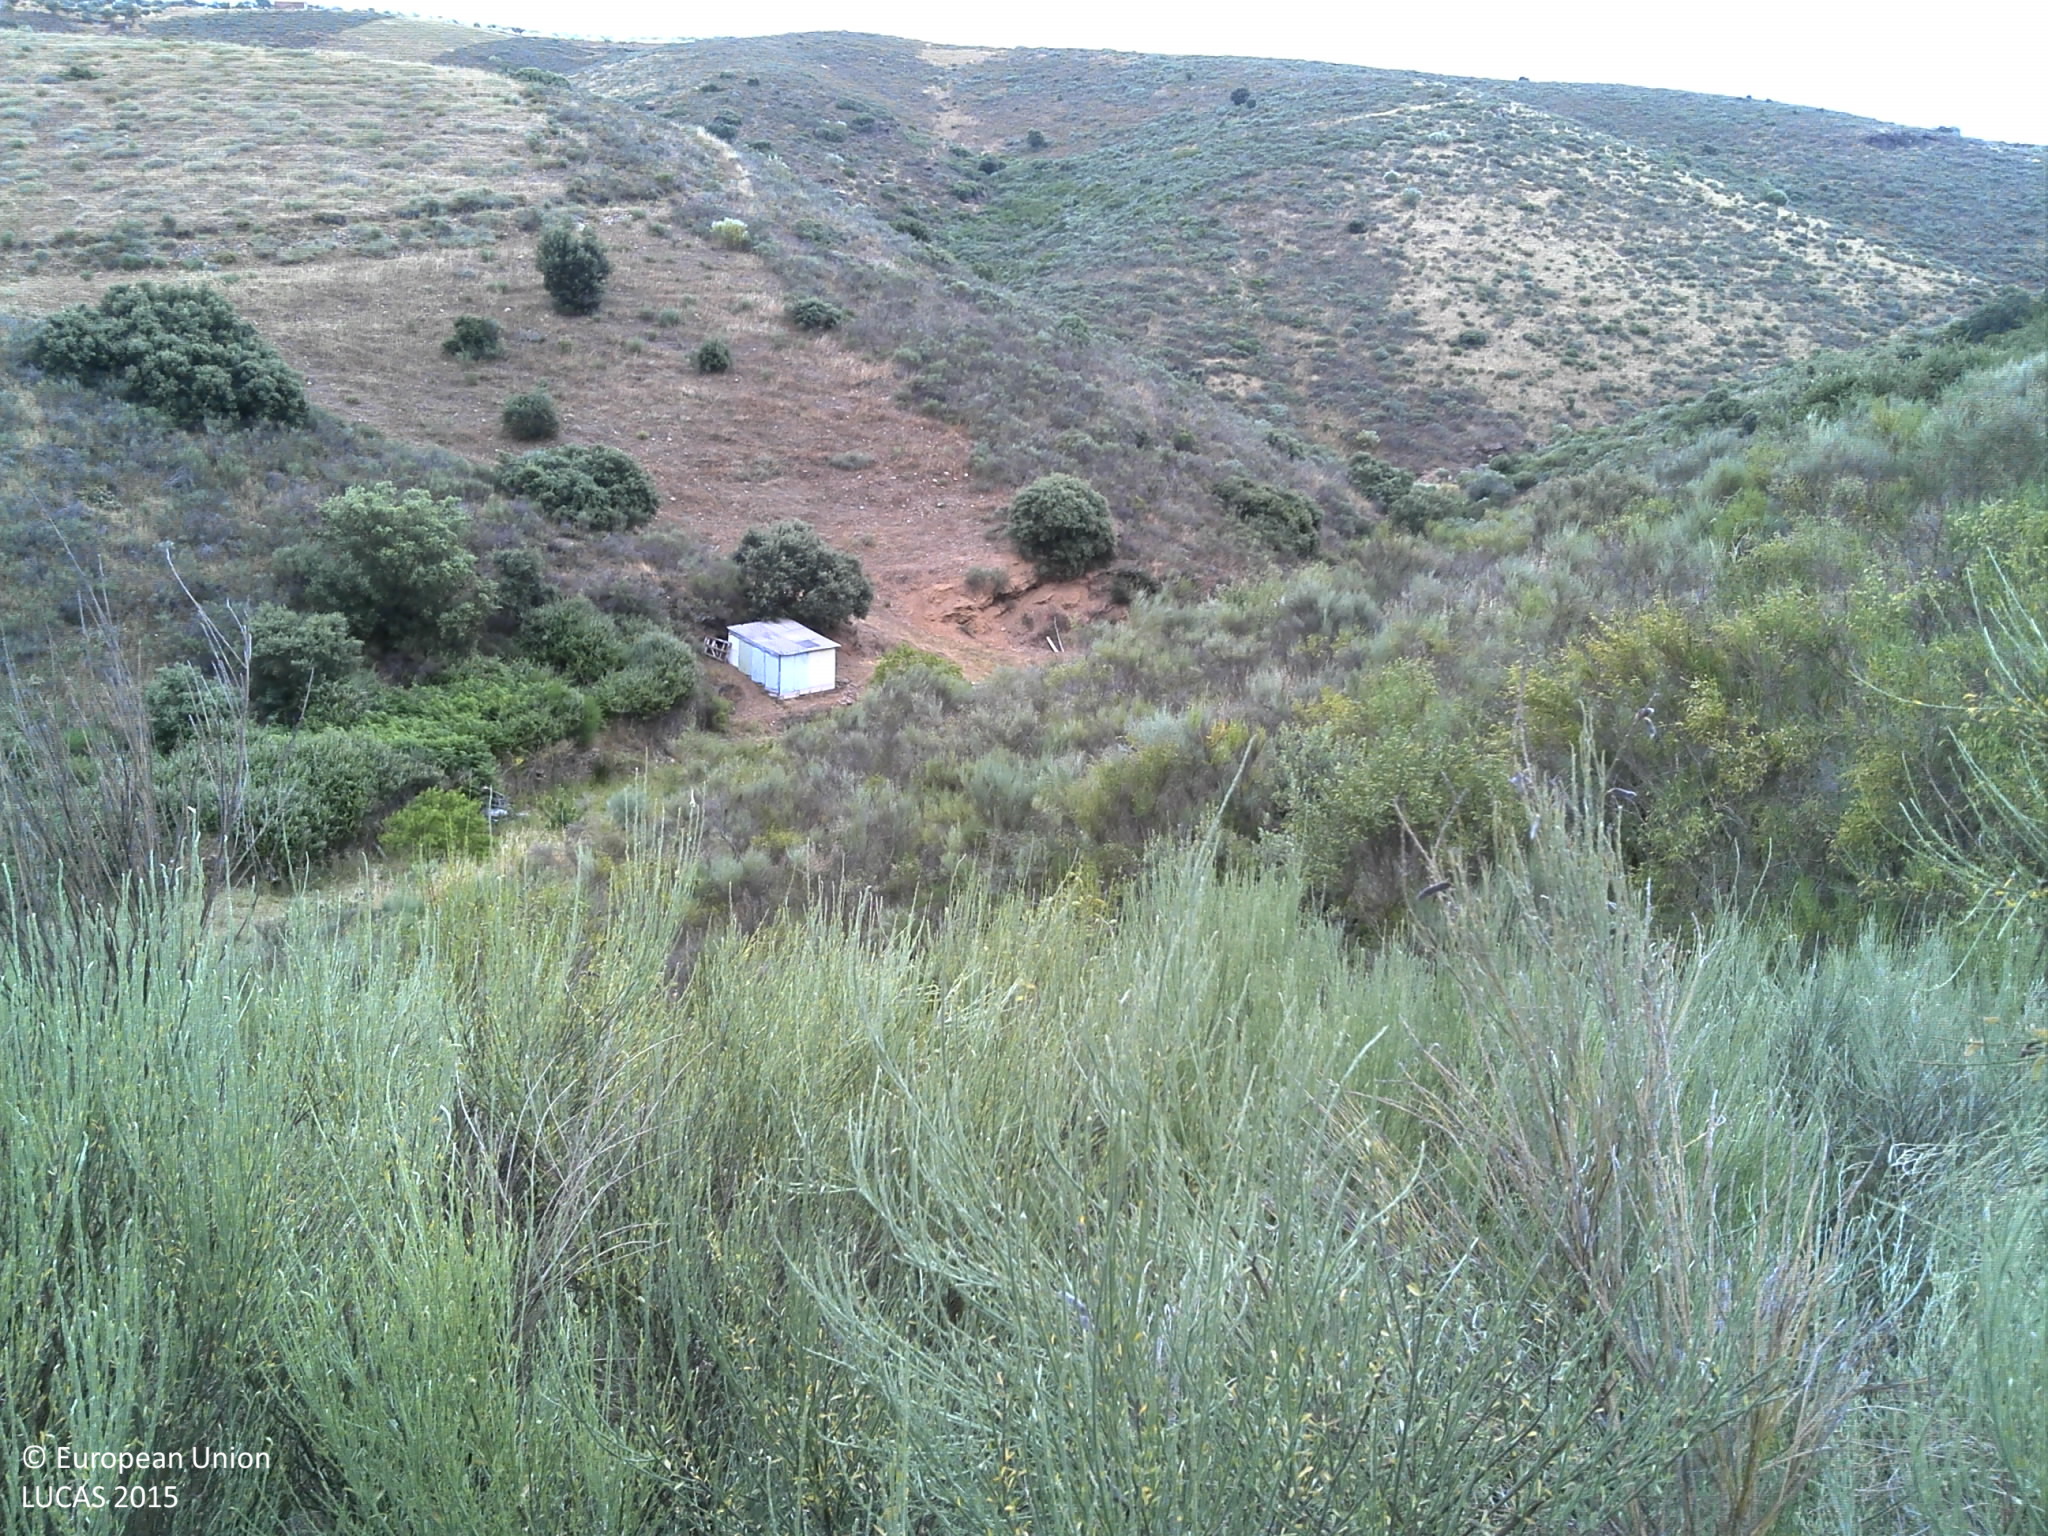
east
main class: Shrubland
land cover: Shrubland without tree cover
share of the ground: > 75 %
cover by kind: shrubs 100 %
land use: Semi-natural and natural areas not in use
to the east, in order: Shrubland without tree cover; Shrubland with sparse tree cover; Tracks; Shrubland with sparse tree cover
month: June
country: PT
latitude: 41.3206
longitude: -6.9676
